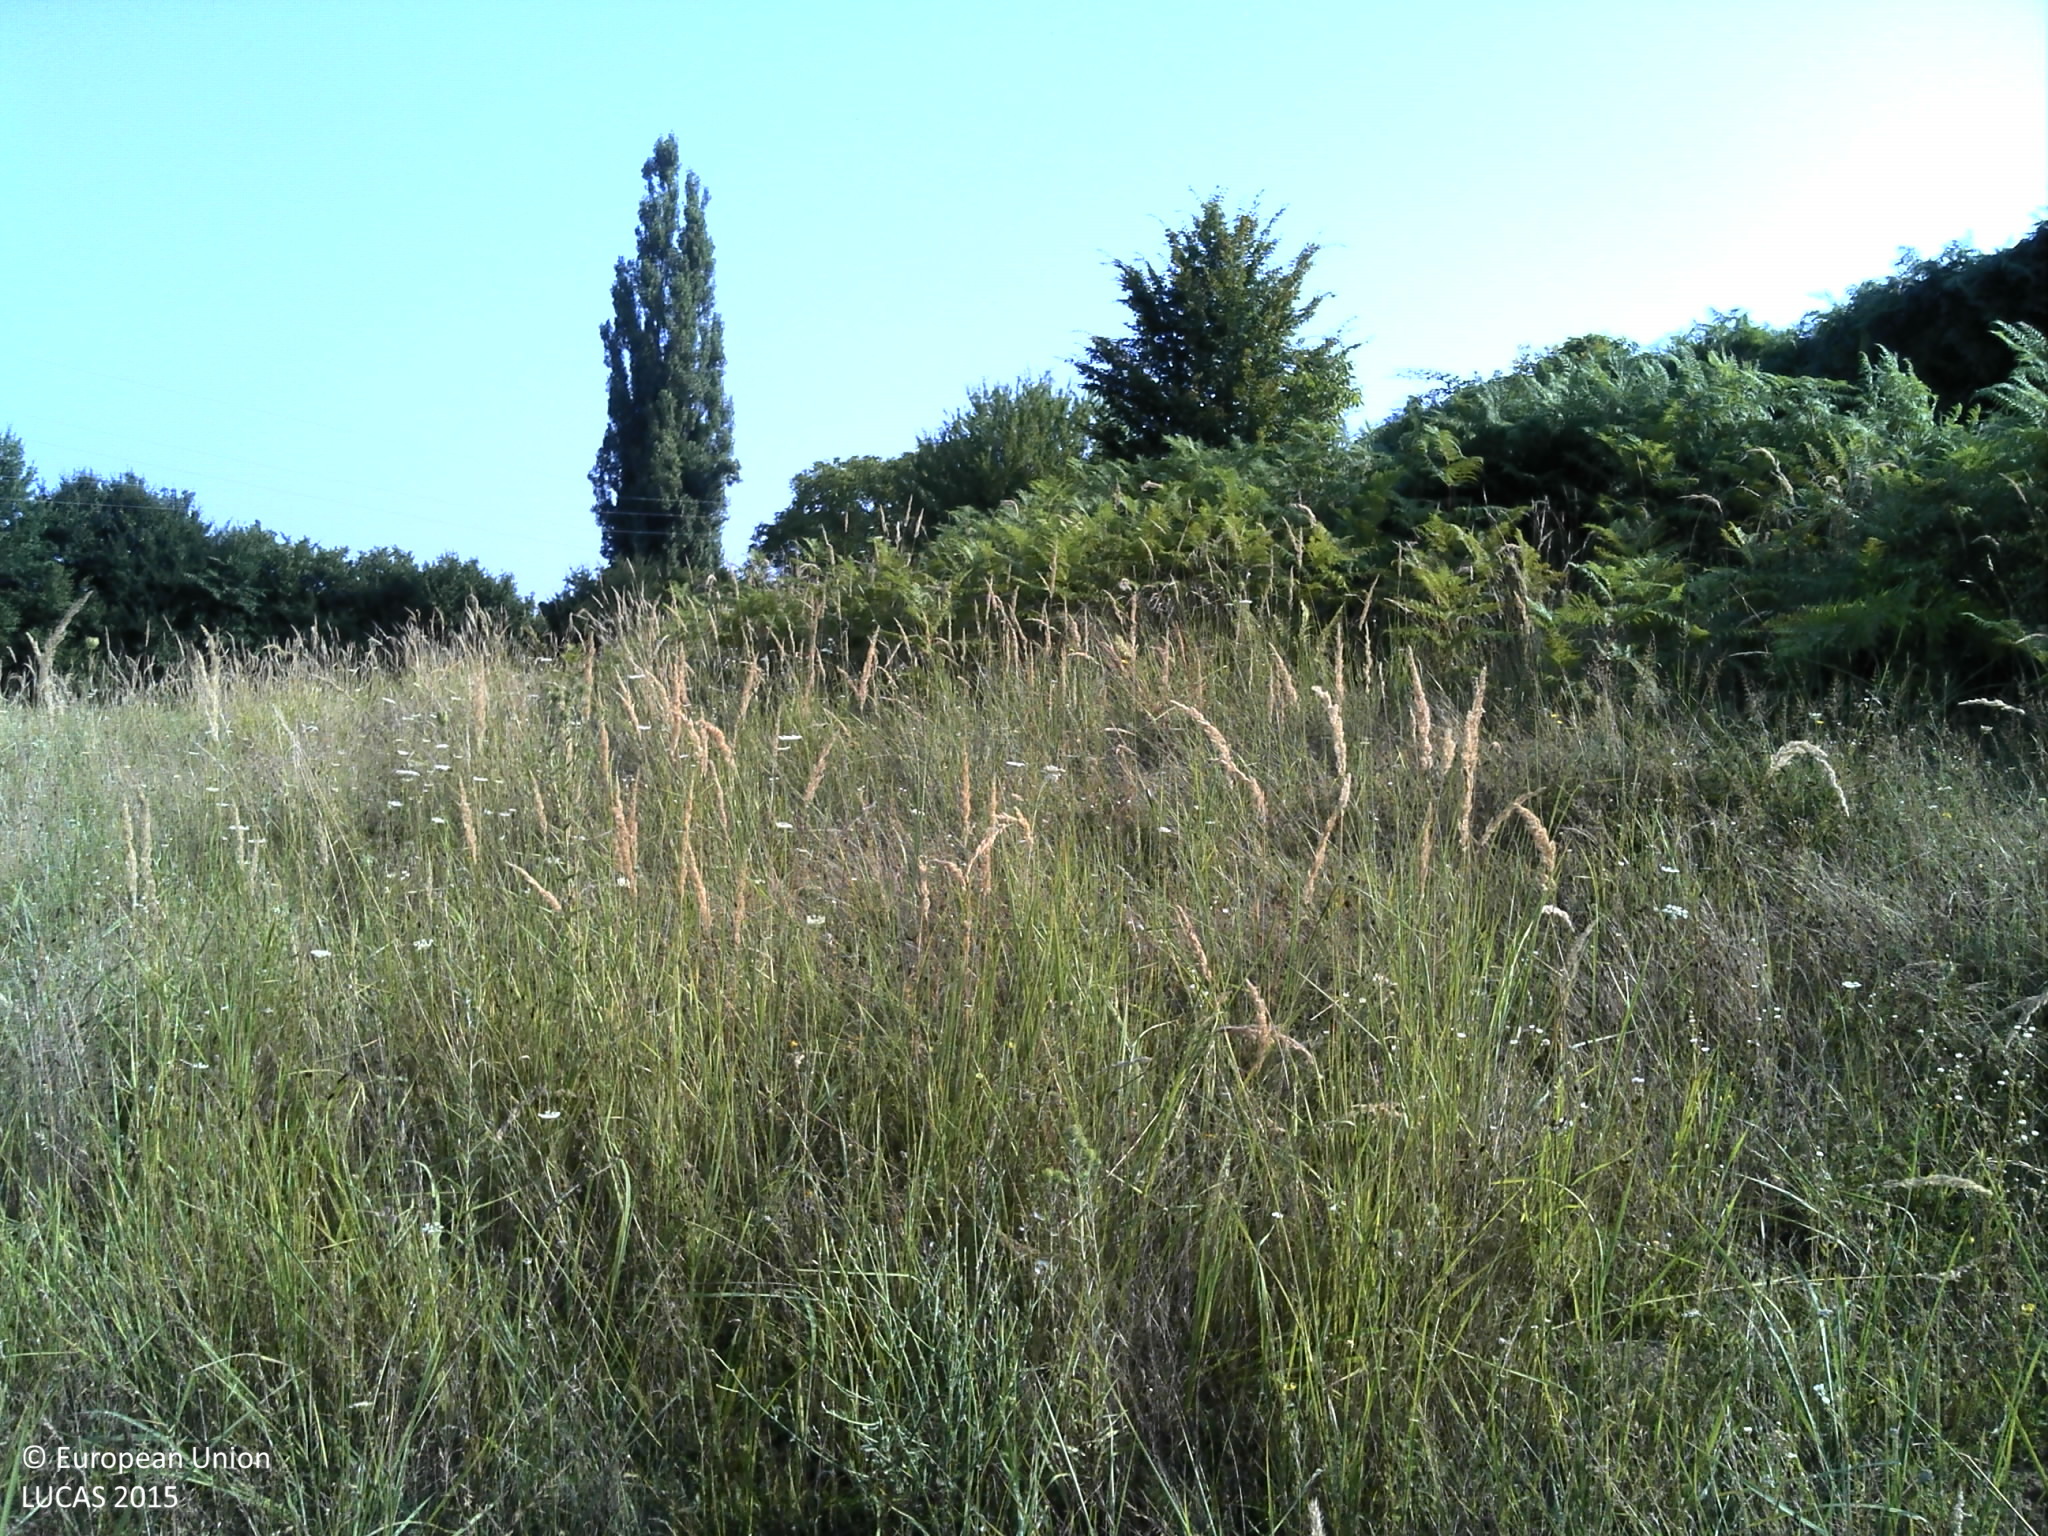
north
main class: Grassland
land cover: Spontaneously vegetated surfaces
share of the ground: > 75 %
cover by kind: herbaceous plants 100 %
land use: Semi-natural and natural areas not in use
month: August
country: HR
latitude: 45.7228
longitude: 17.2865
